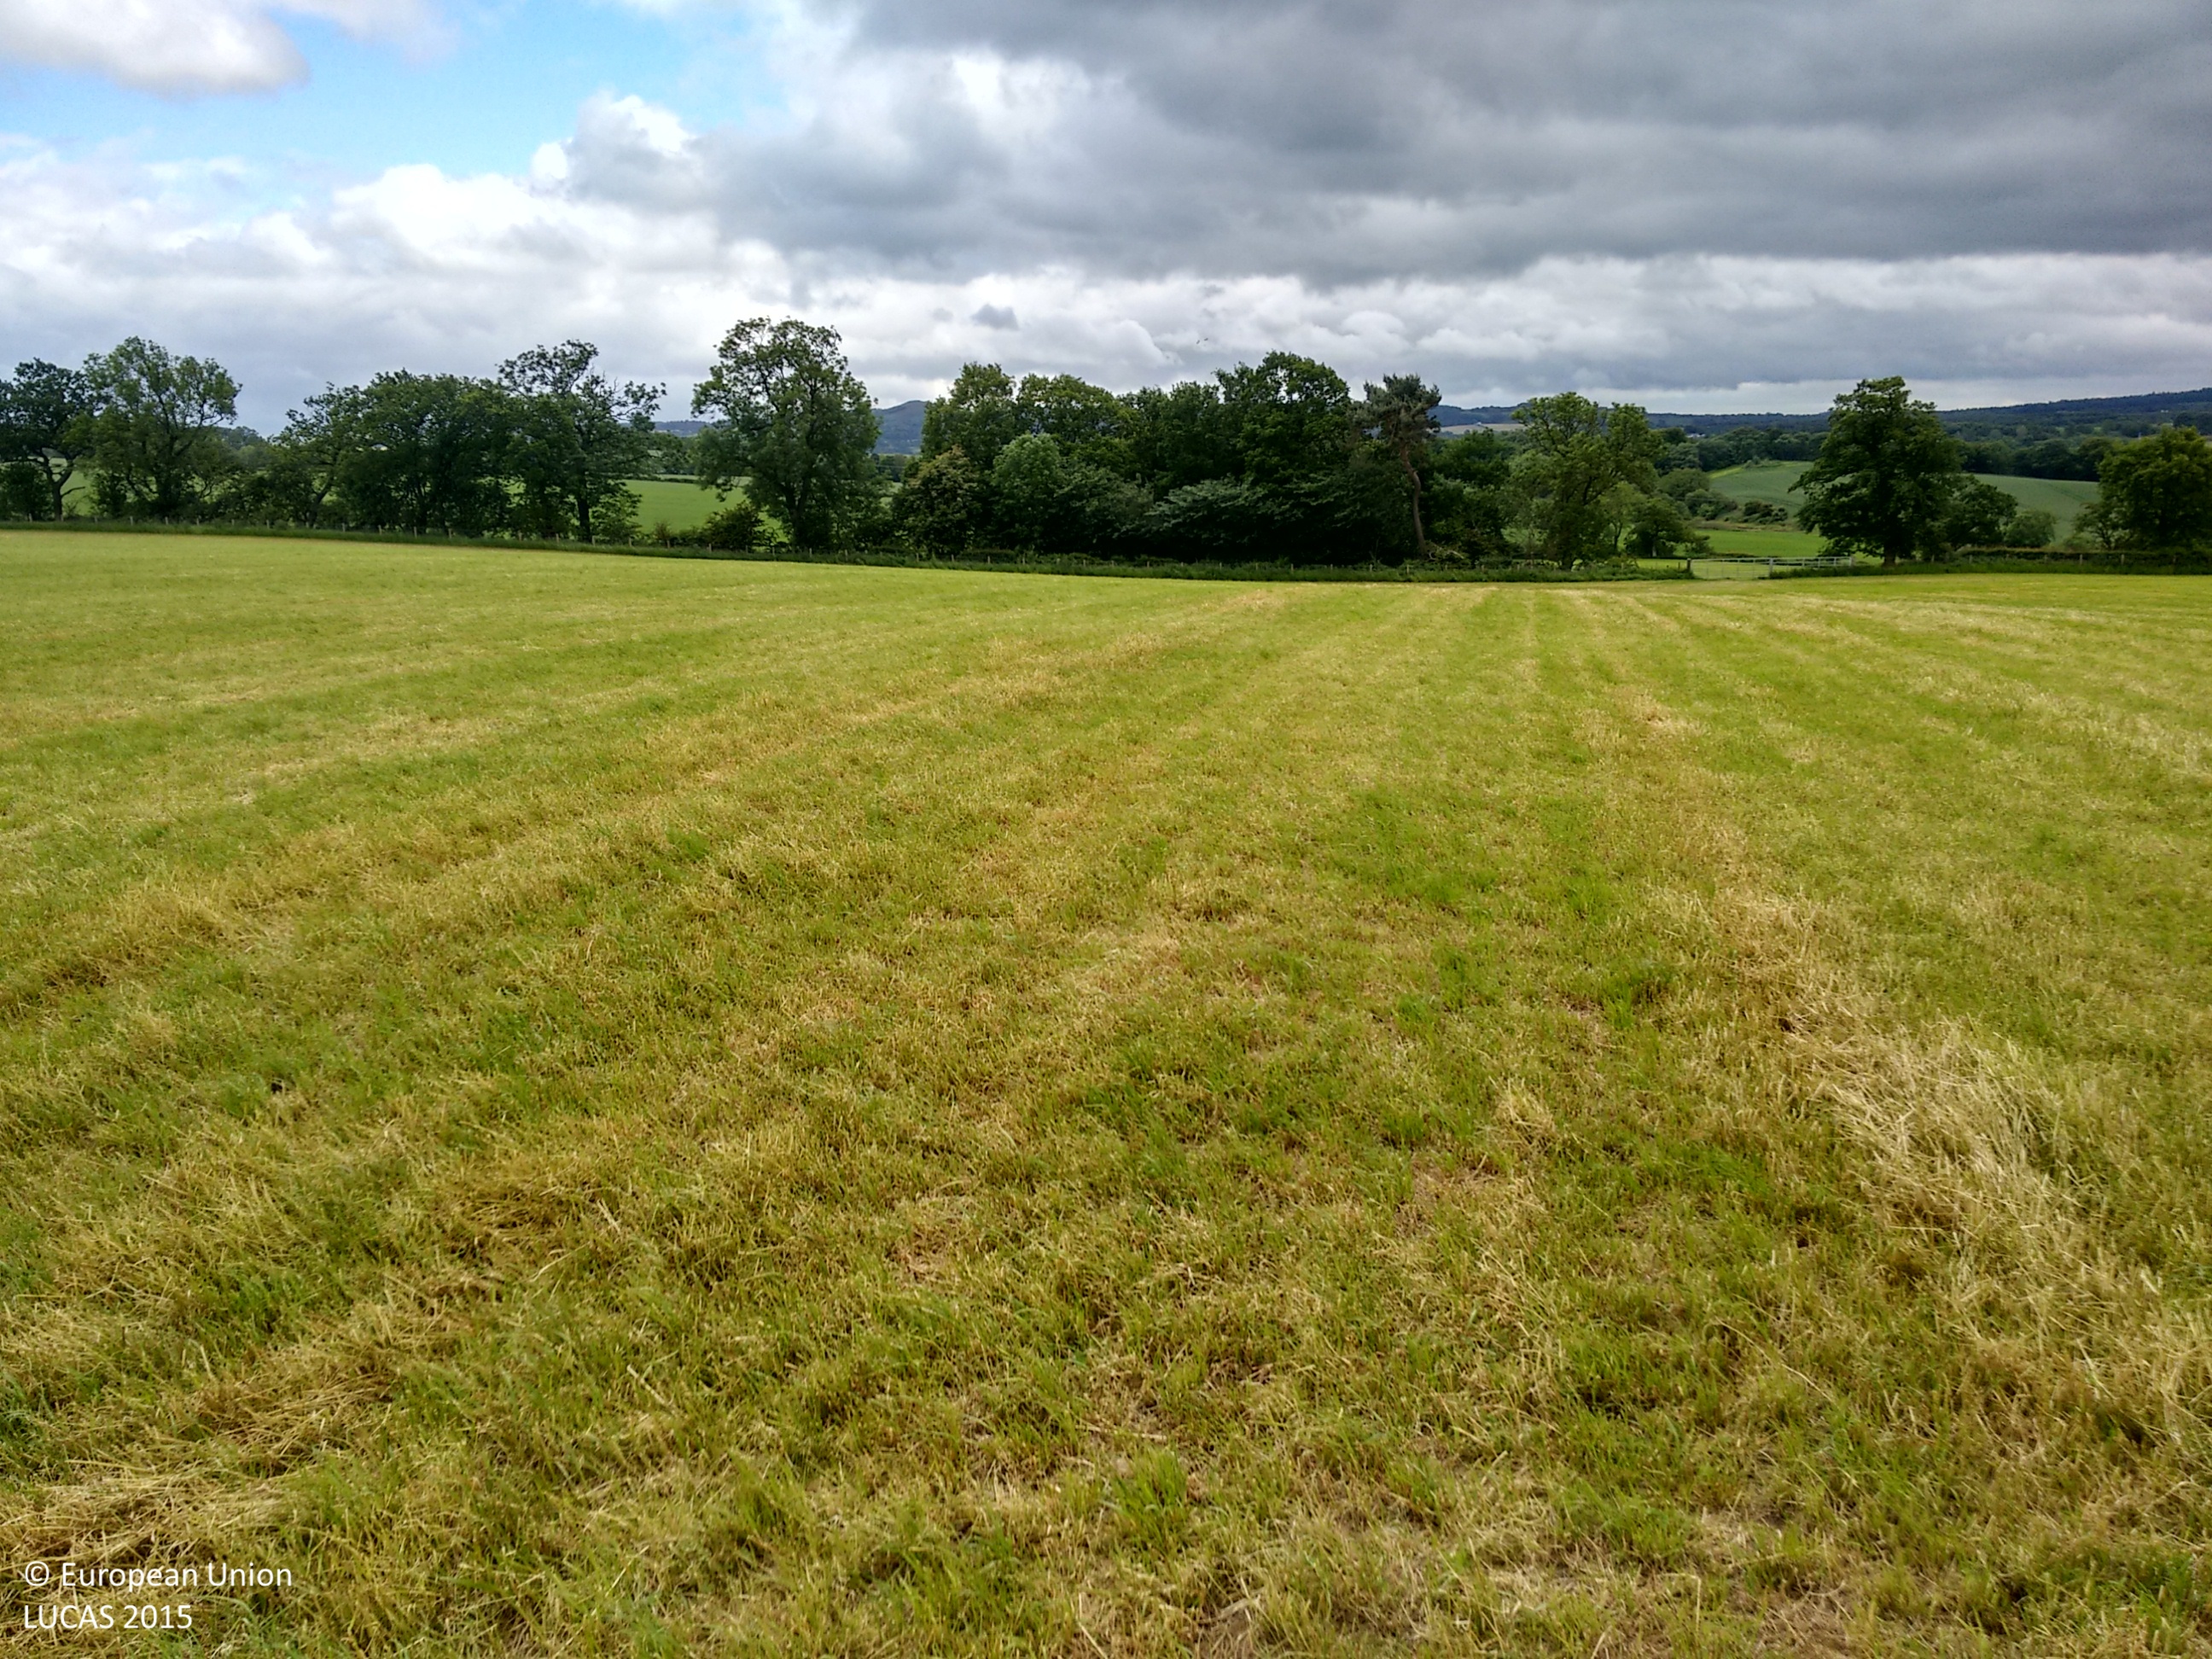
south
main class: Grassland
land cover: Grassland without tree/shrub cover
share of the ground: > 75 %
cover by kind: herbaceous plants 100 %
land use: Agriculture (excluding fallow land and kitchen gardens)
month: June
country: GB
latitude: 56.0004
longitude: -3.6619
